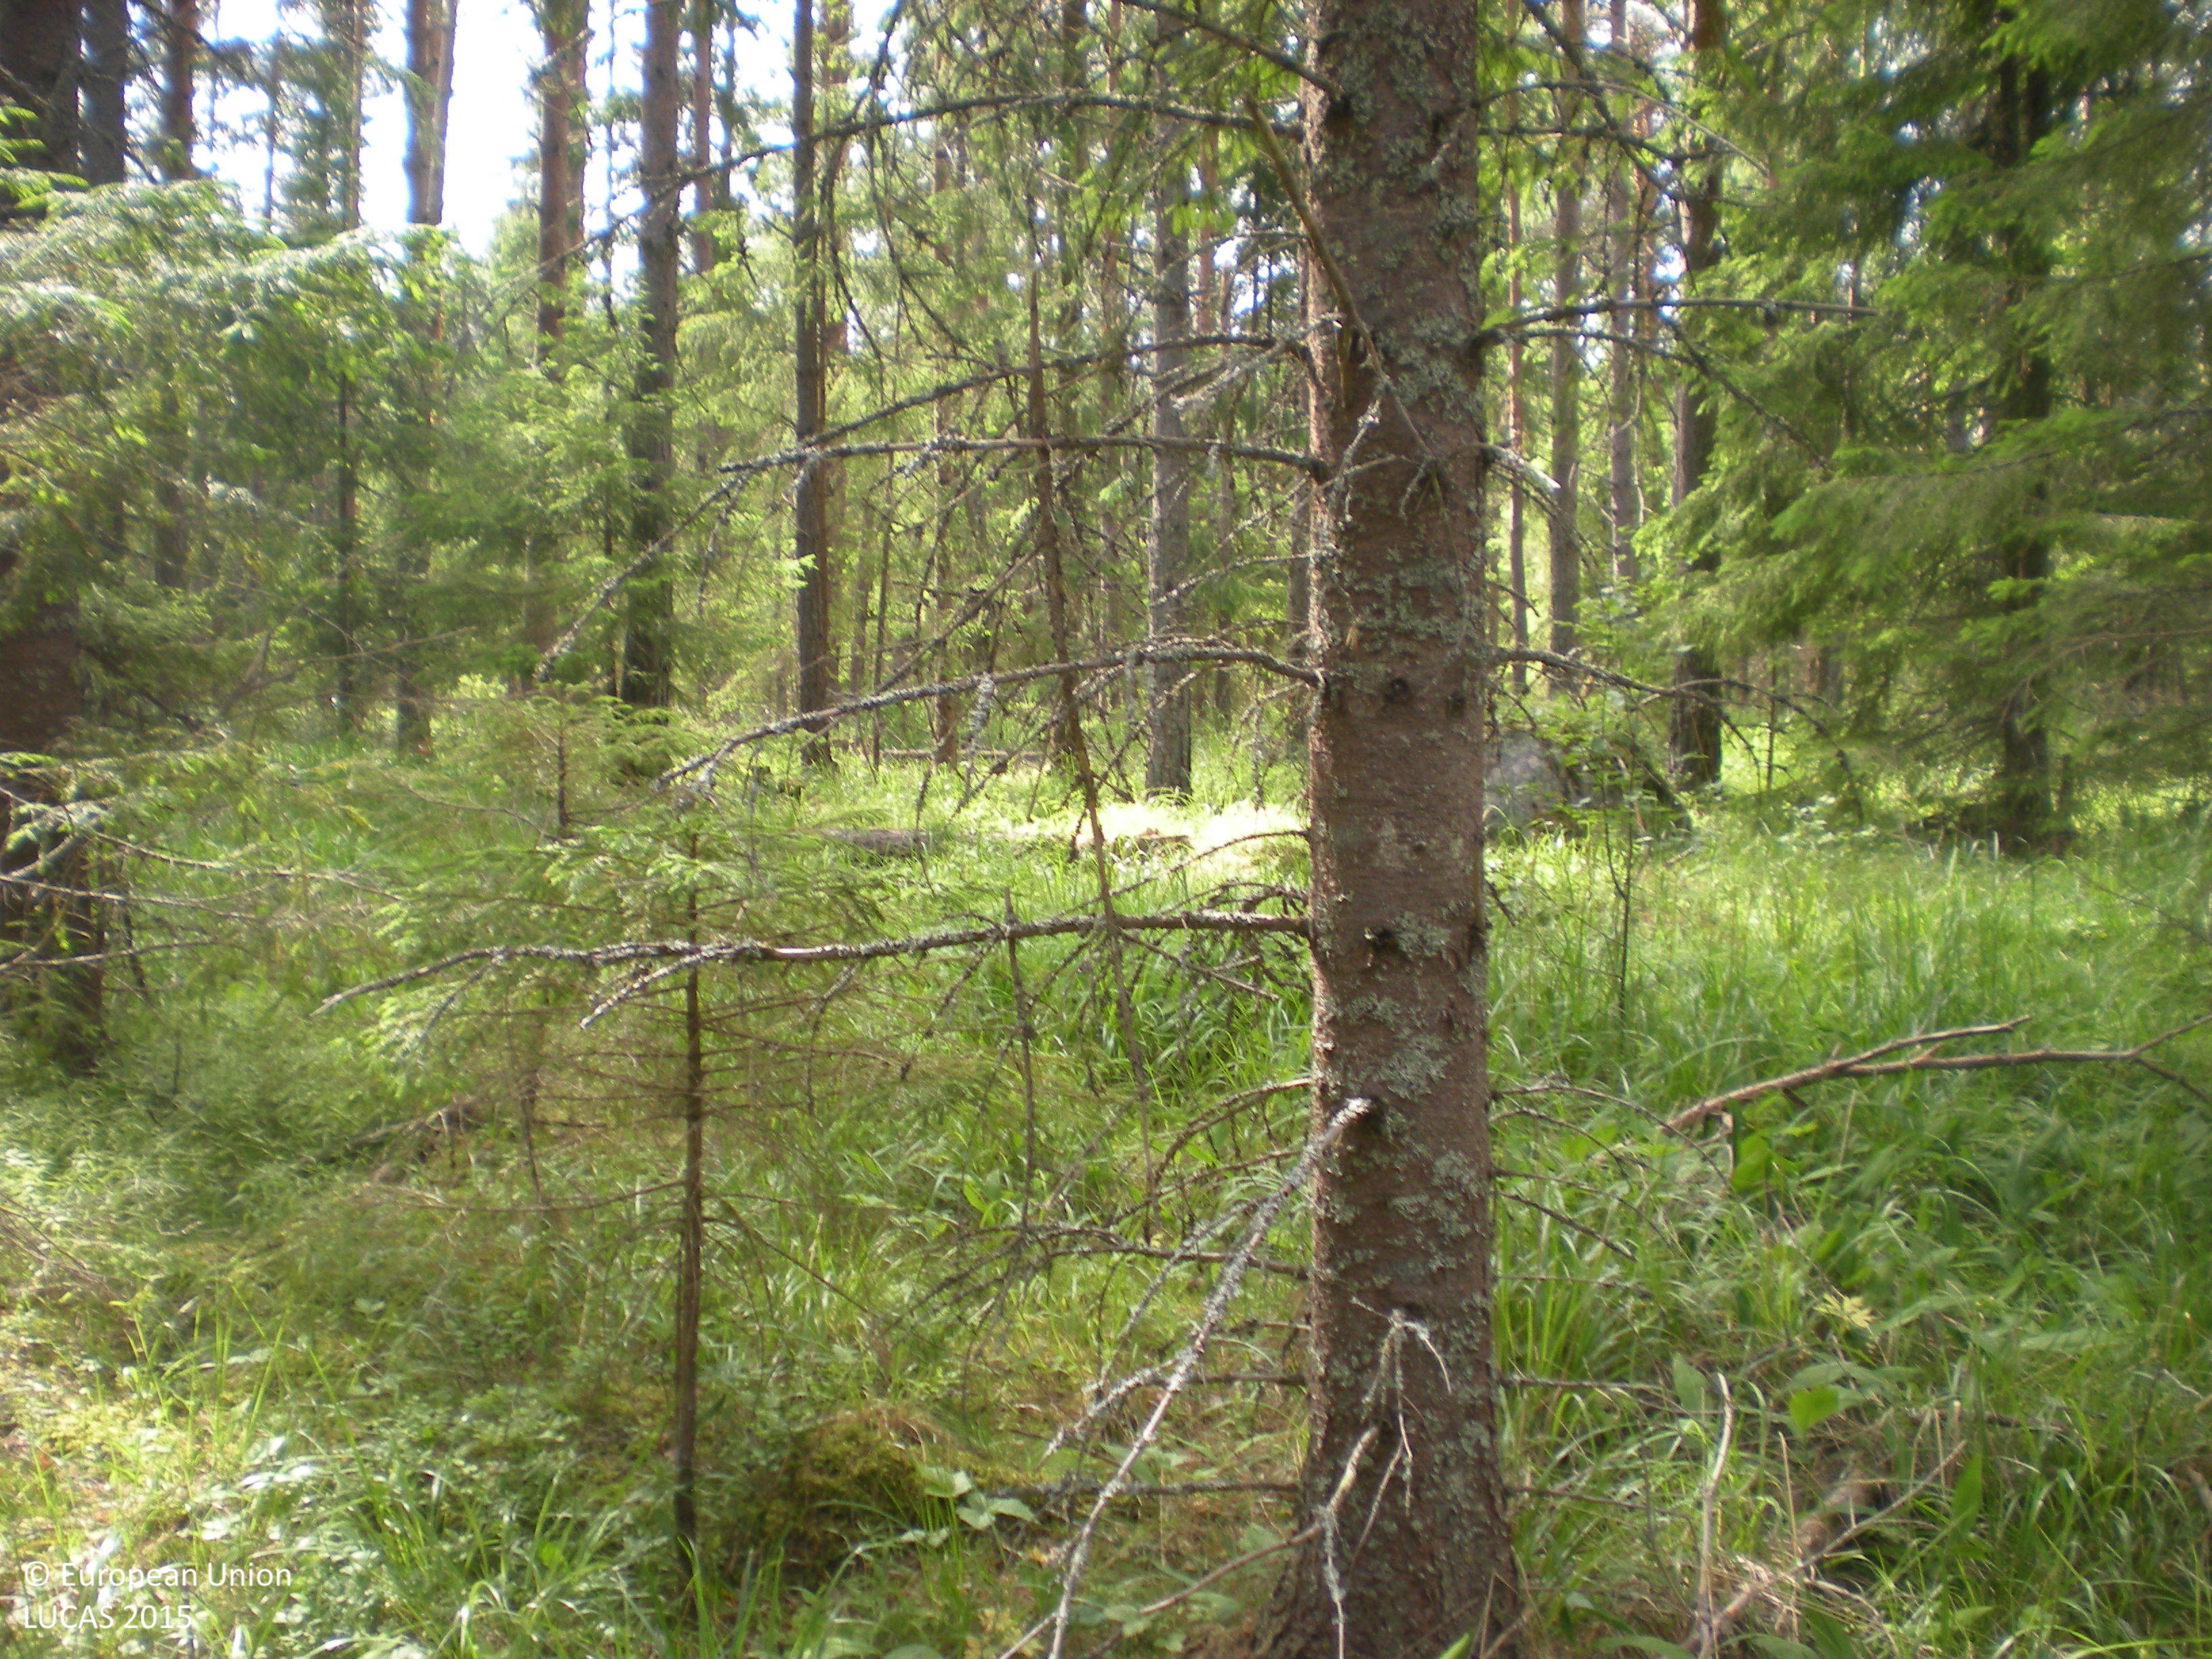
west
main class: Woodland
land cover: Other coniferous woodland
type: boreal forest
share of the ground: 50 - 75 %
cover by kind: coniferous forest trees 70 %, herbaceous plants 15 %, lichens and mosses 10 %, consolidated bare surface 5 %
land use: Forestry
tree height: > 5 m
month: June
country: SE
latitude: 60.4301
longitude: 17.8950
